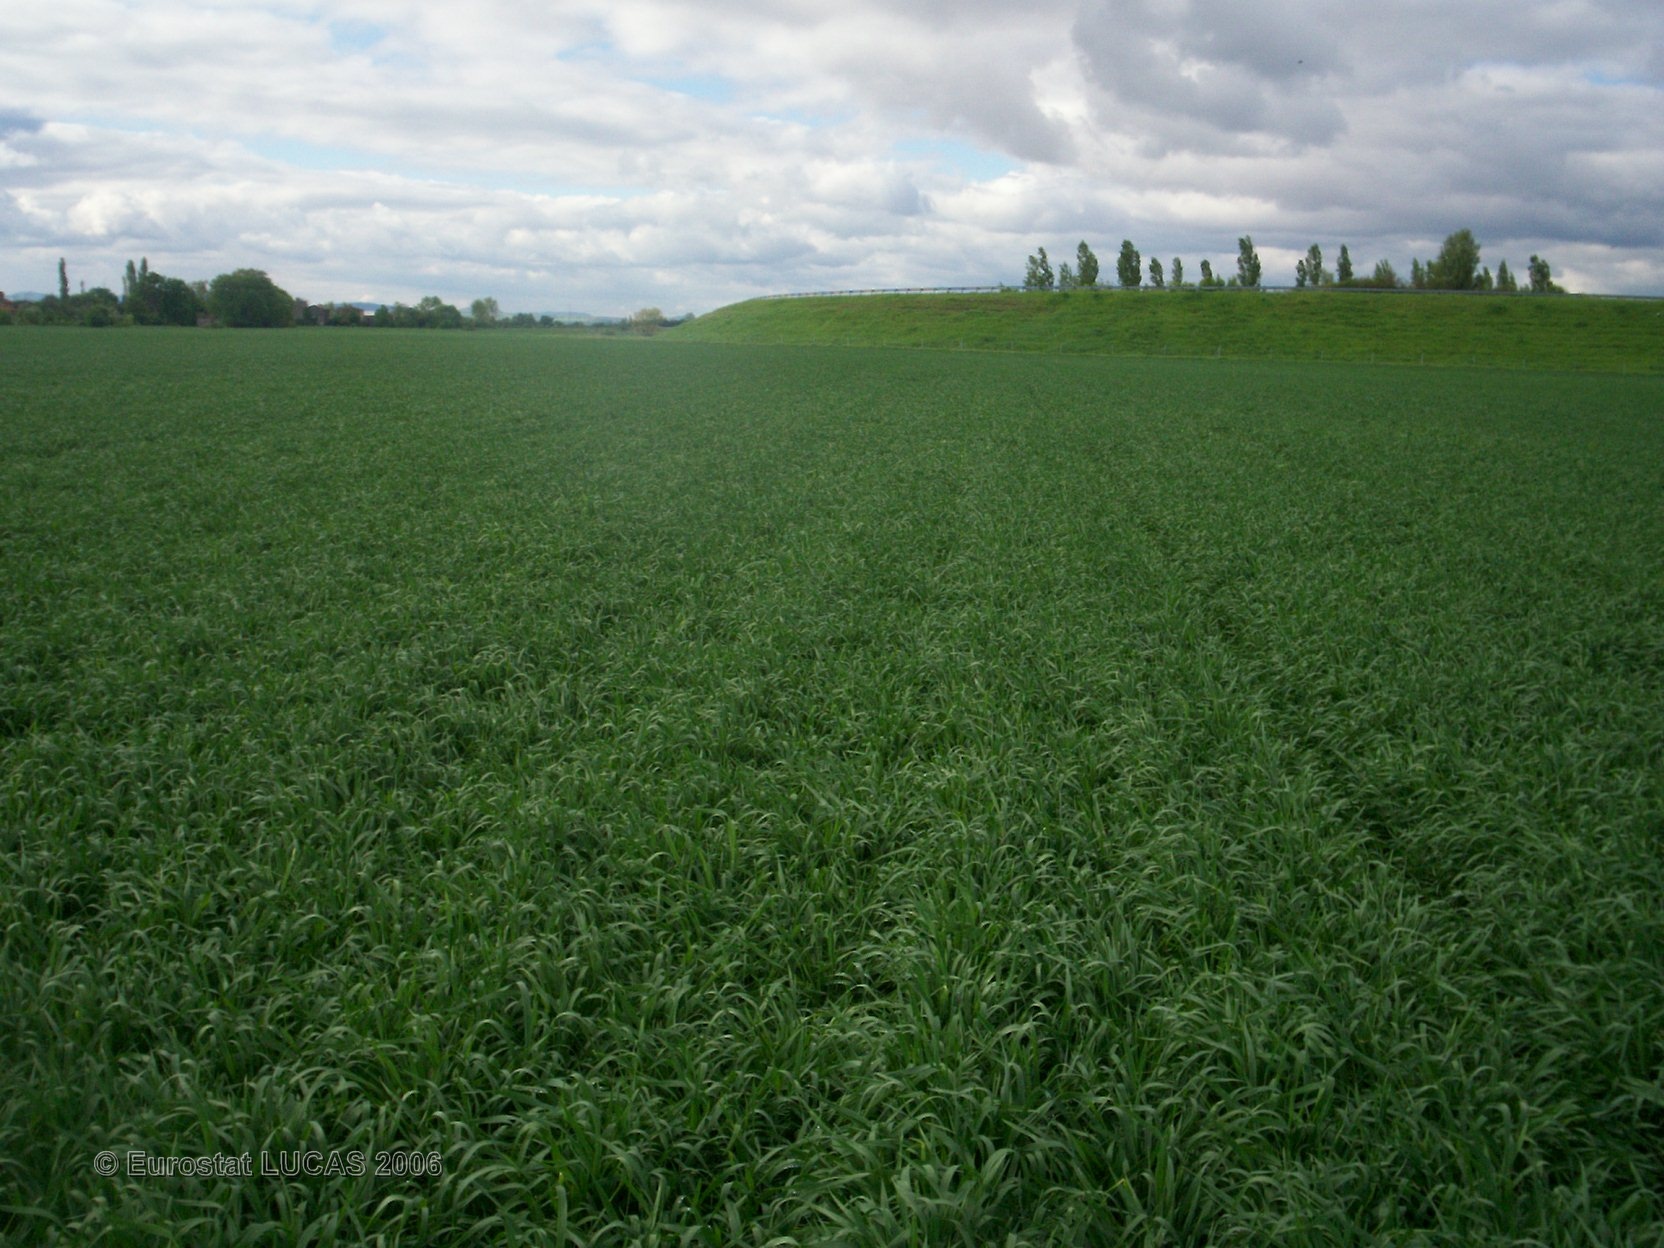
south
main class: Cropland
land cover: Barley
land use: Agriculture (excluding fallow land and kitchen gardens)
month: May
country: FR
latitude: 45.8969
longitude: 3.1557
